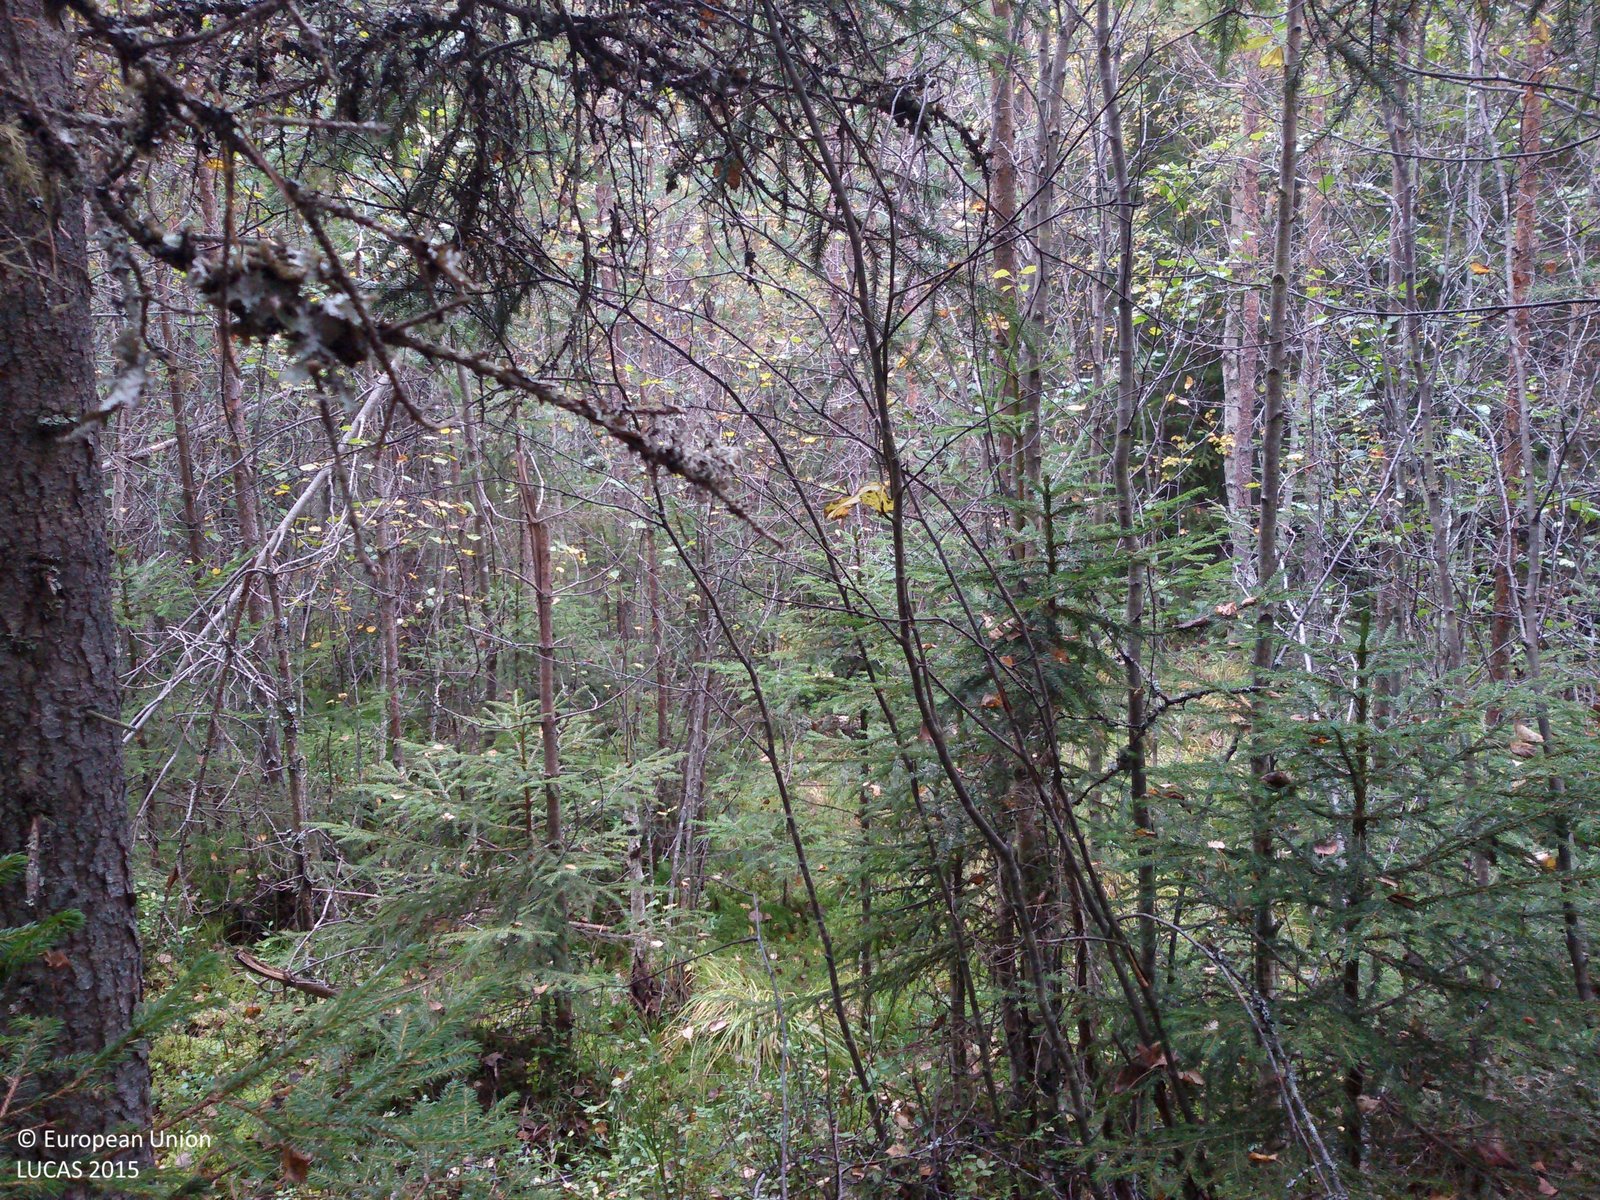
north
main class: Woodland
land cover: Spruce dominated mixed woodland
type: boreal forest
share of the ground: > 75 %
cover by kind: coniferous forest trees 50 %, broadleaved forest trees 50 %
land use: Forestry
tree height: > 5 m
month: September
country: SE
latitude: 60.7469
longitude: 14.8485
